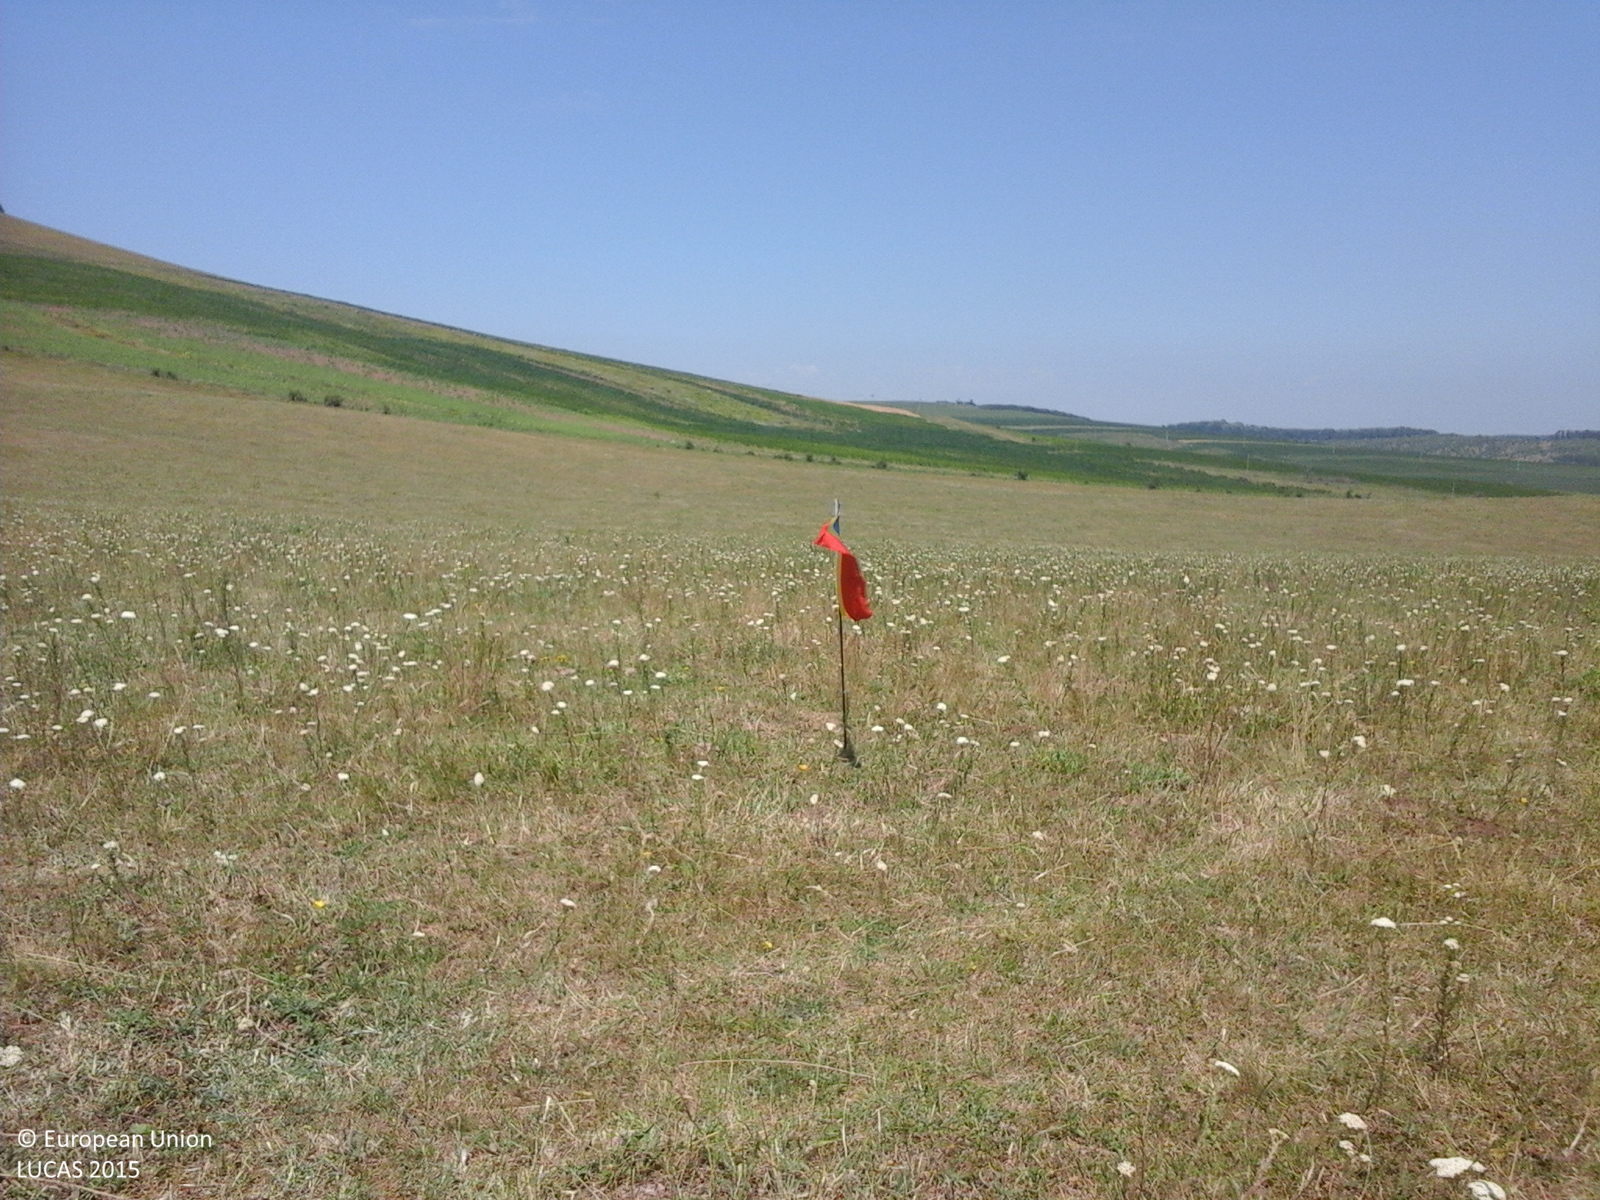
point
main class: Grassland
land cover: Grassland without tree/shrub cover
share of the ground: > 75 %
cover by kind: herbaceous plants 100 %
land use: Agriculture (excluding fallow land and kitchen gardens)
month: June
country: RO
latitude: 46.8749
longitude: 27.8777
